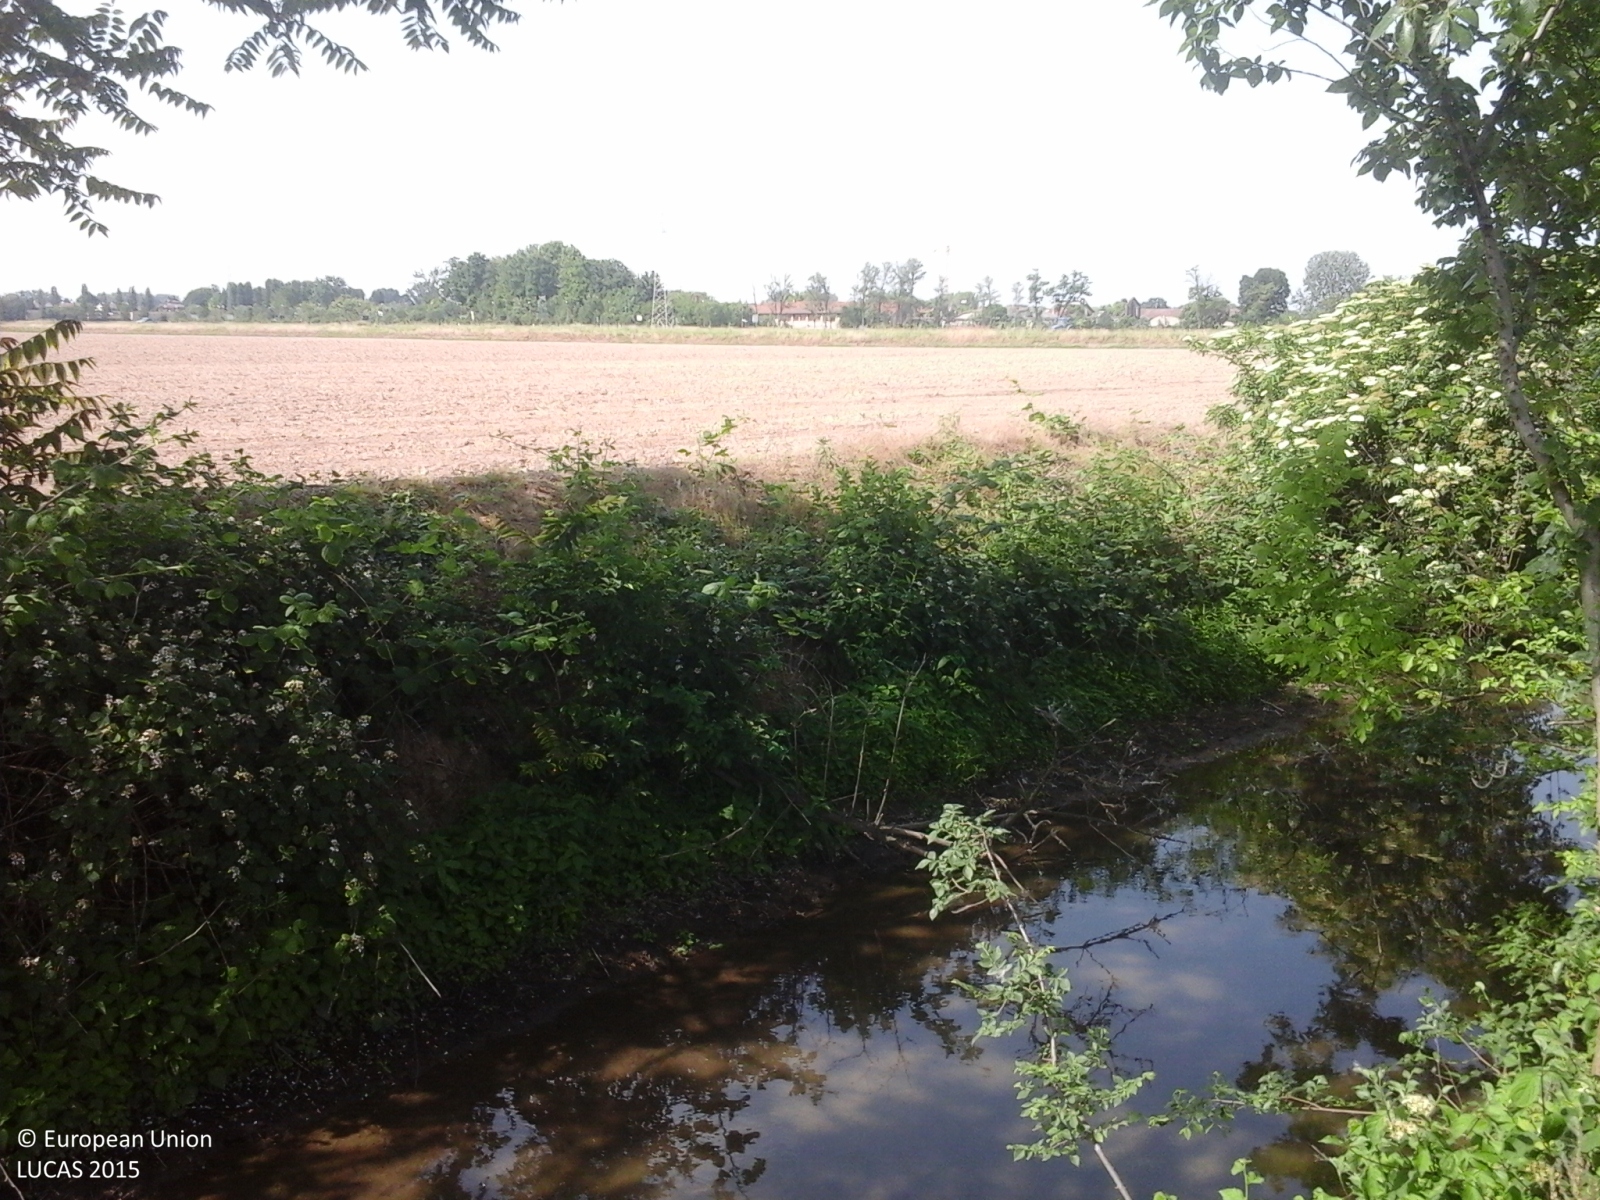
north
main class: Cropland
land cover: Rice
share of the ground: > 75 %
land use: Agriculture (excluding fallow land and kitchen gardens)
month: May
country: IT
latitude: 45.3389
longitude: 9.1720
